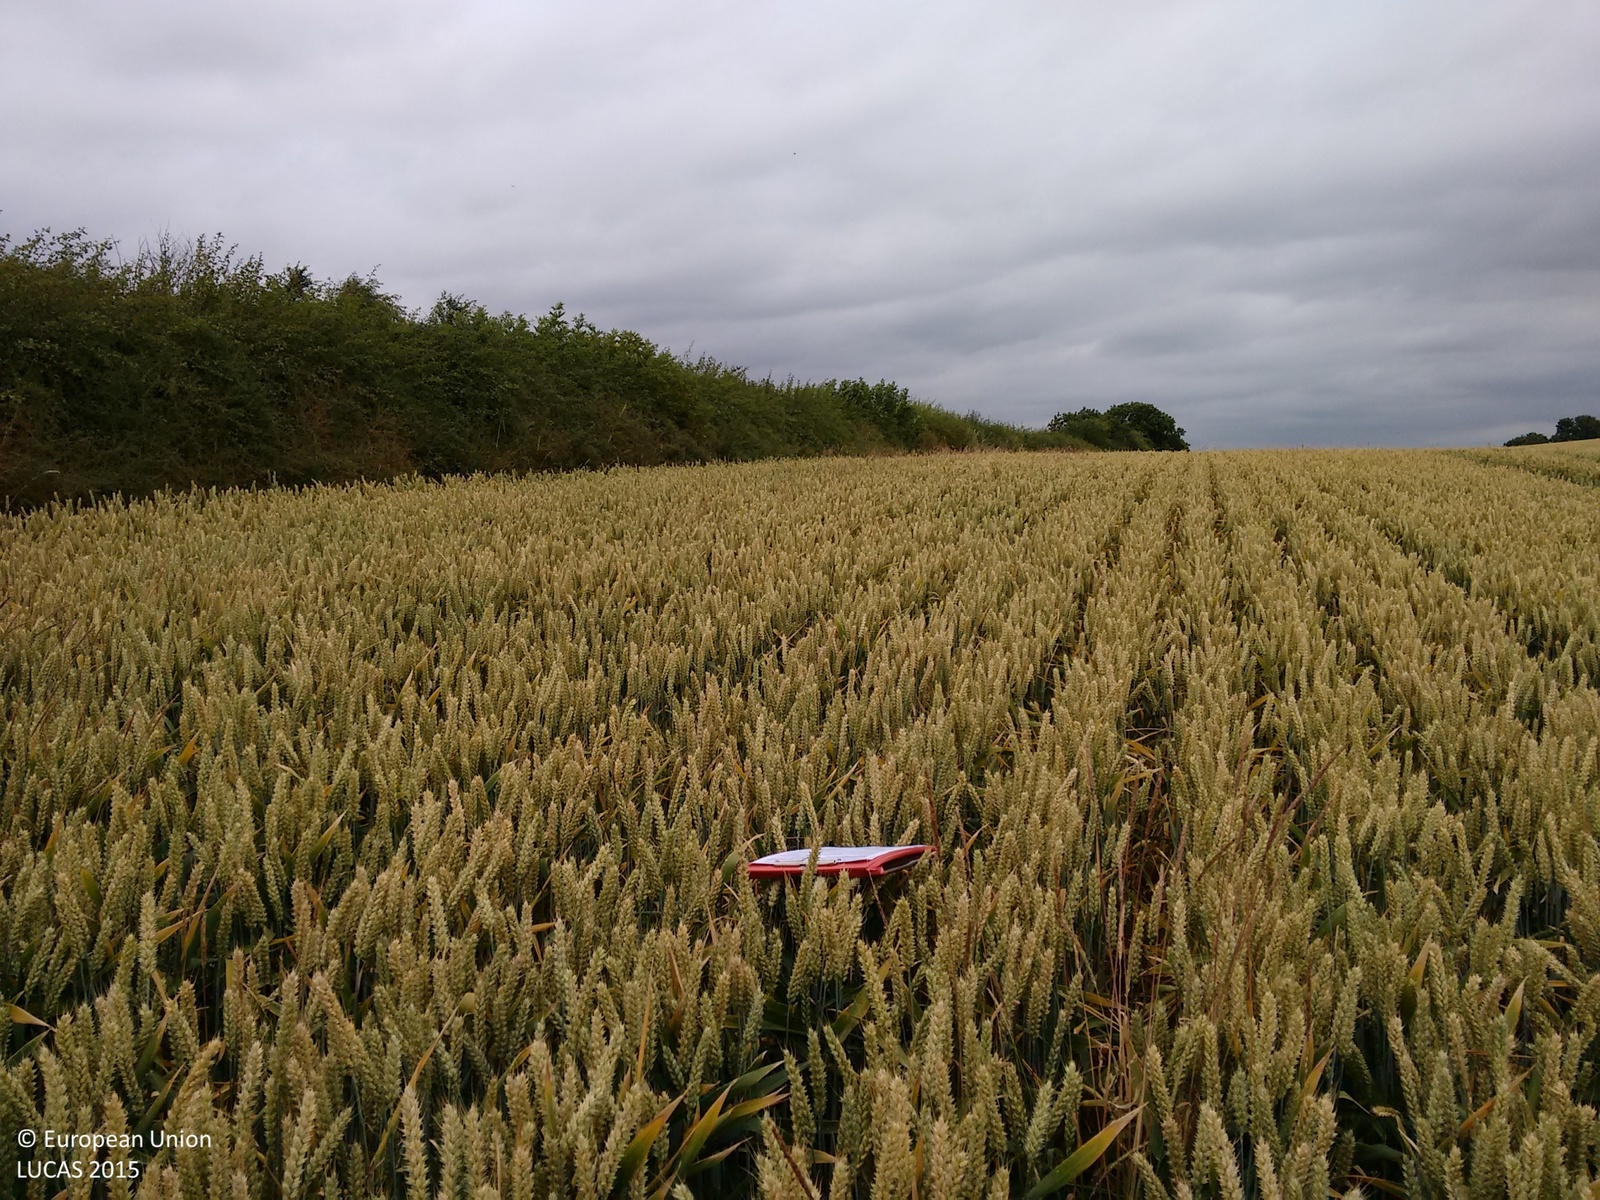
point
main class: Cropland
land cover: Common wheat
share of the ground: > 75 %
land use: Agriculture (excluding fallow land and kitchen gardens)
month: July
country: GB
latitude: 52.4530
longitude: -0.9176
